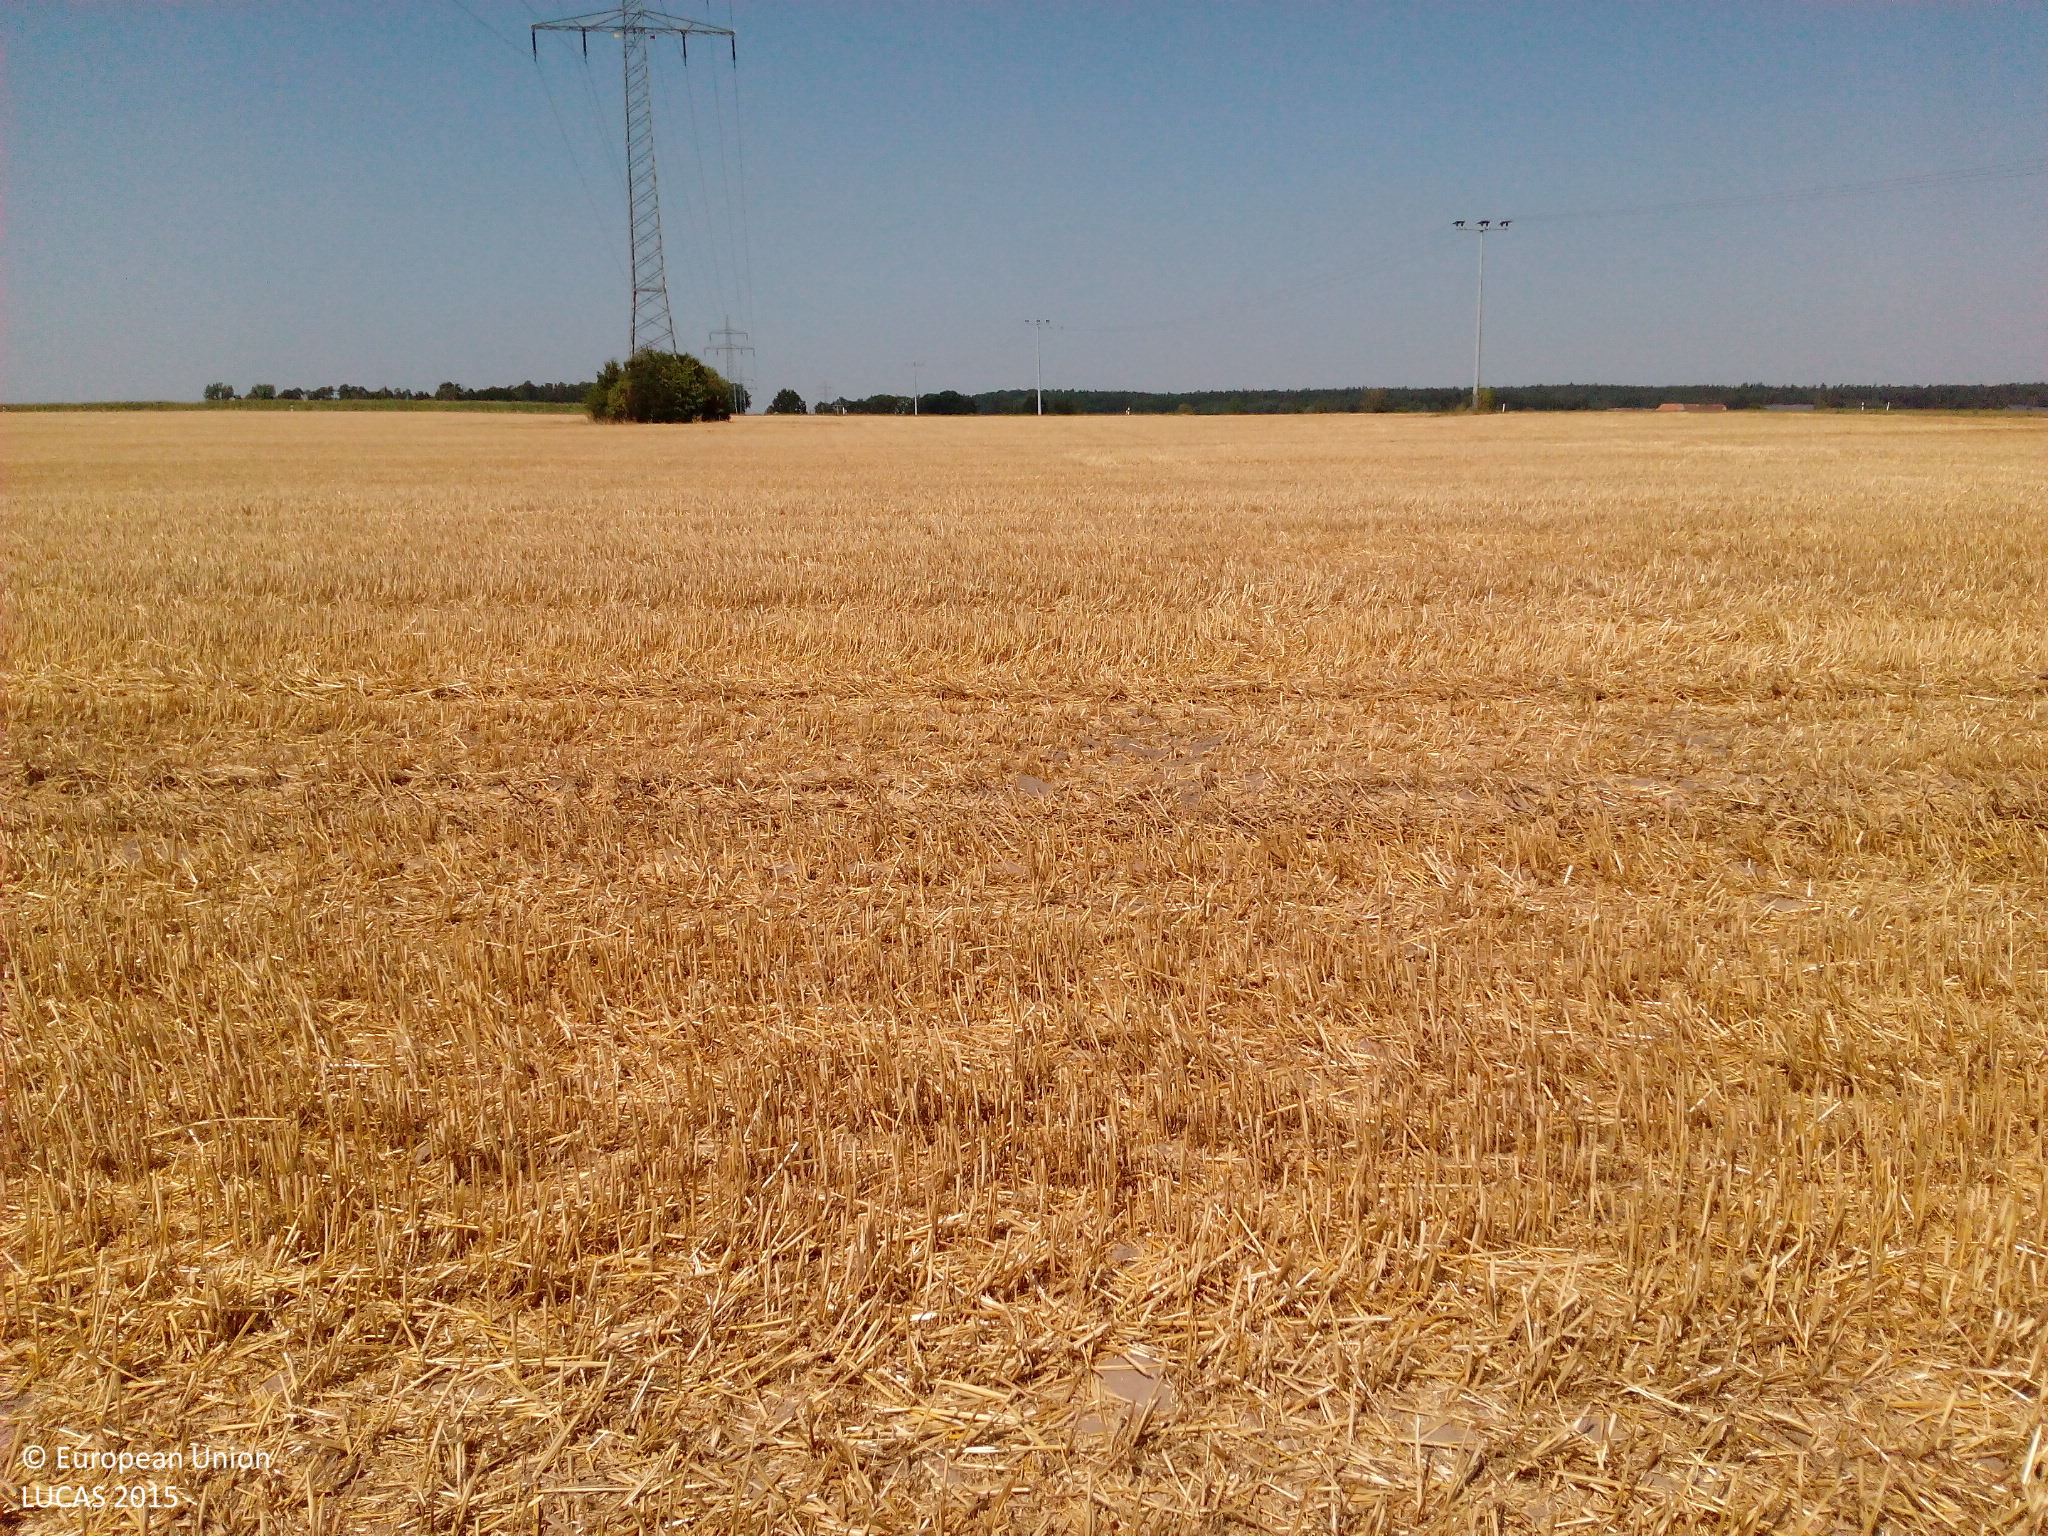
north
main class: Cropland
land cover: Common wheat
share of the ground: < 10 %
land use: Agriculture (excluding fallow land and kitchen gardens)
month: August
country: DE
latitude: 49.1047
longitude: 10.3149
